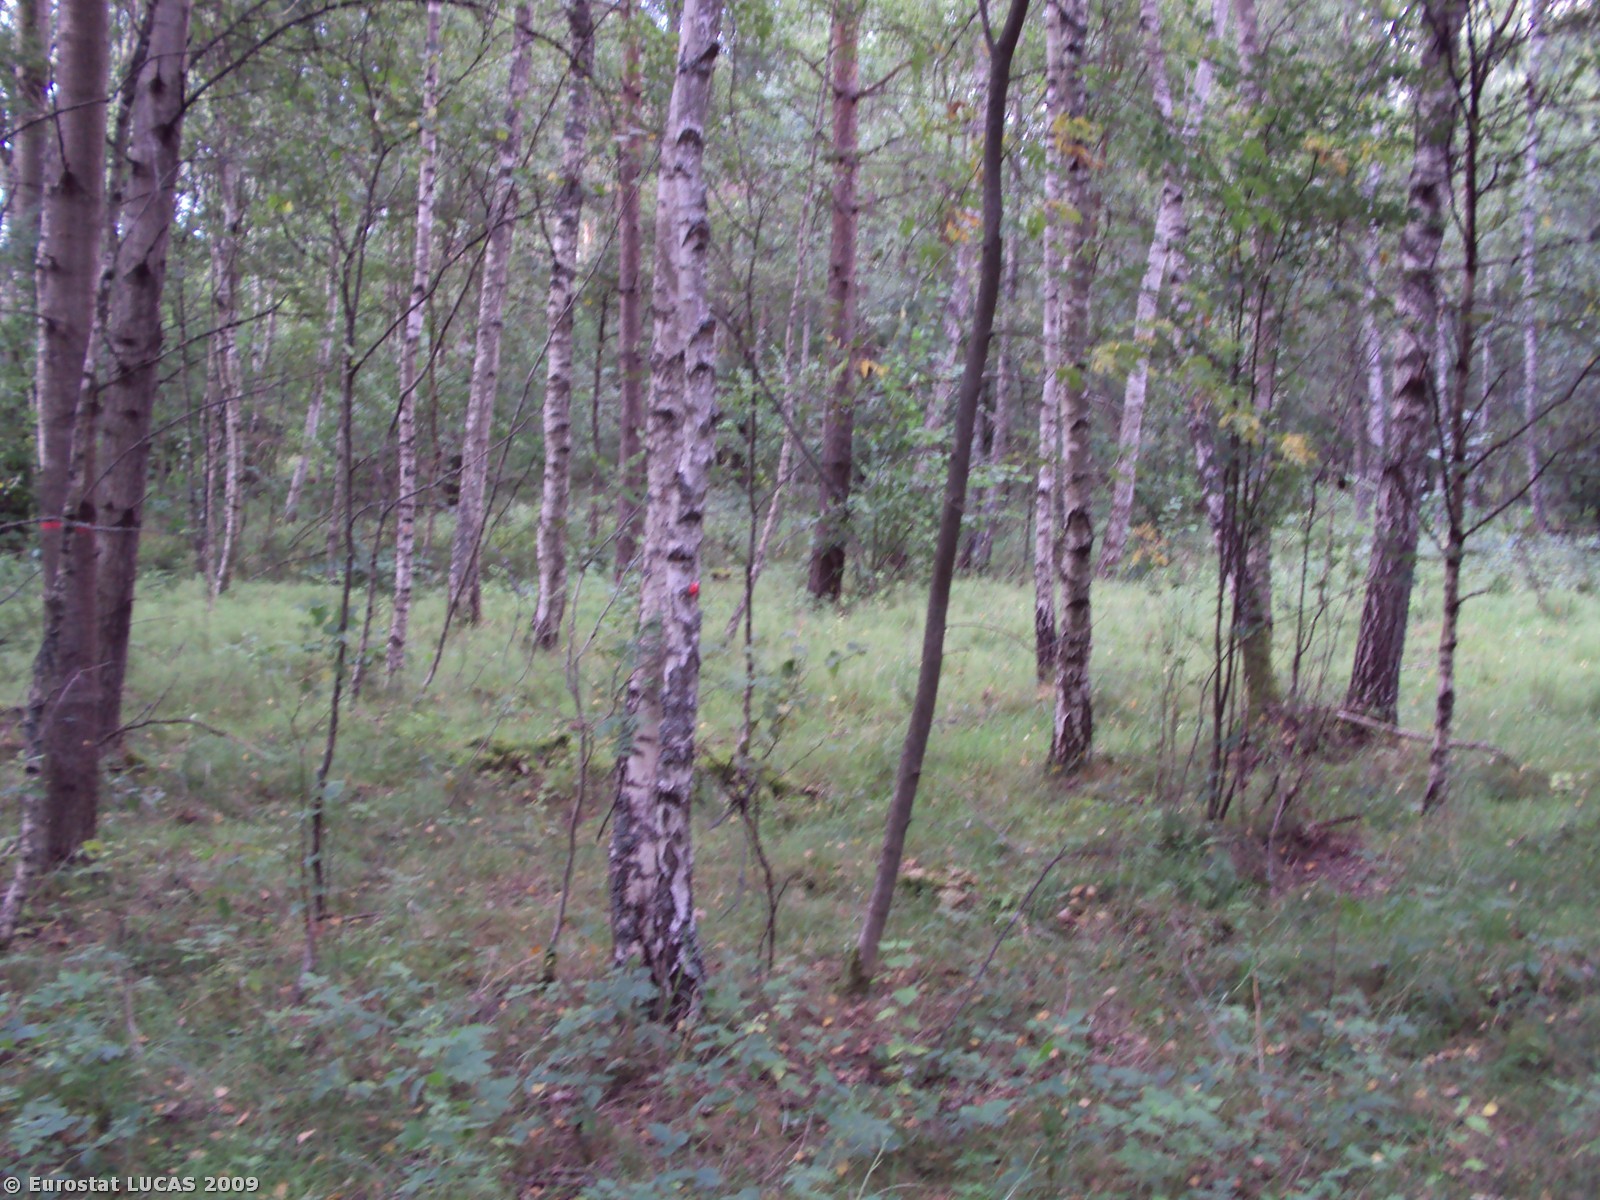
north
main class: Woodland
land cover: Mixed woodland
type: hemiboreal forest and nemoral coniferous forest and mixed broadleaved-coniferous forest
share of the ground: > 75 %
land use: Forestry
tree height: > 5 m
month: August
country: PL
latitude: 53.4928
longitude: 16.5941
